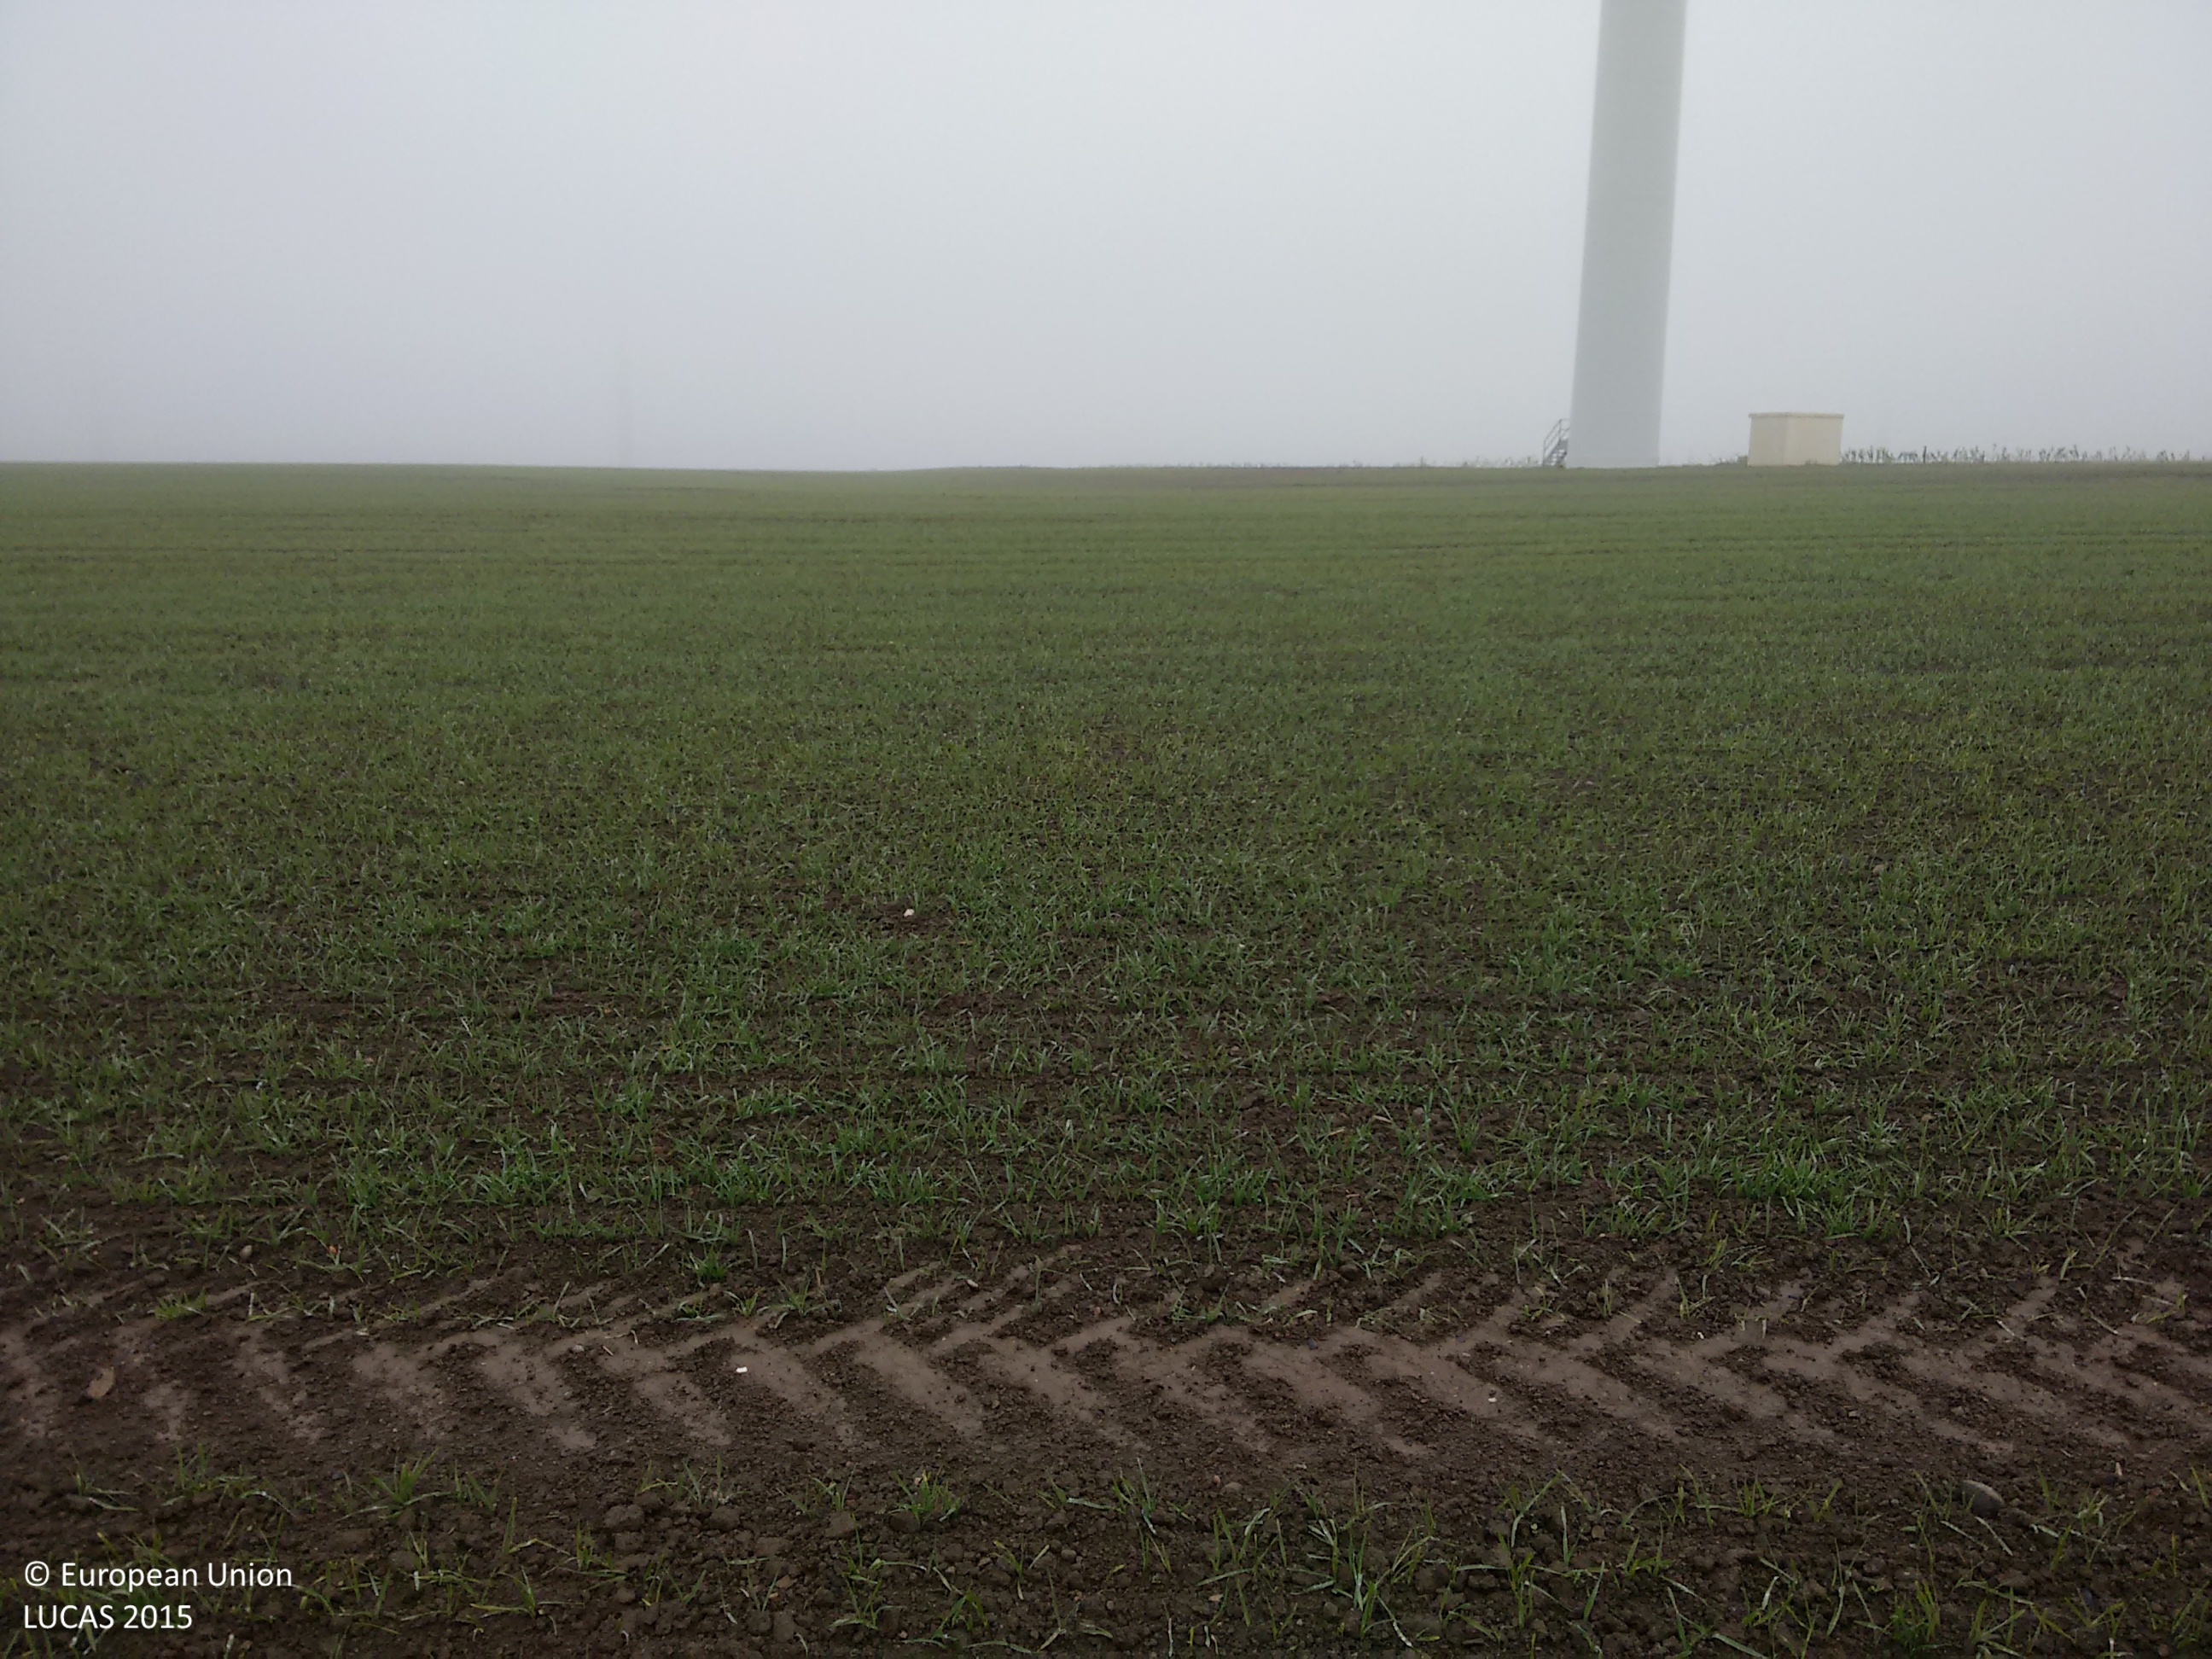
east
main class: Cropland
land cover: Common wheat
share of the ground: > 75 %
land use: Agriculture (excluding fallow land and kitchen gardens)
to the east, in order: Common wheat
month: May
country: GB
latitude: 55.2082
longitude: -1.5664
